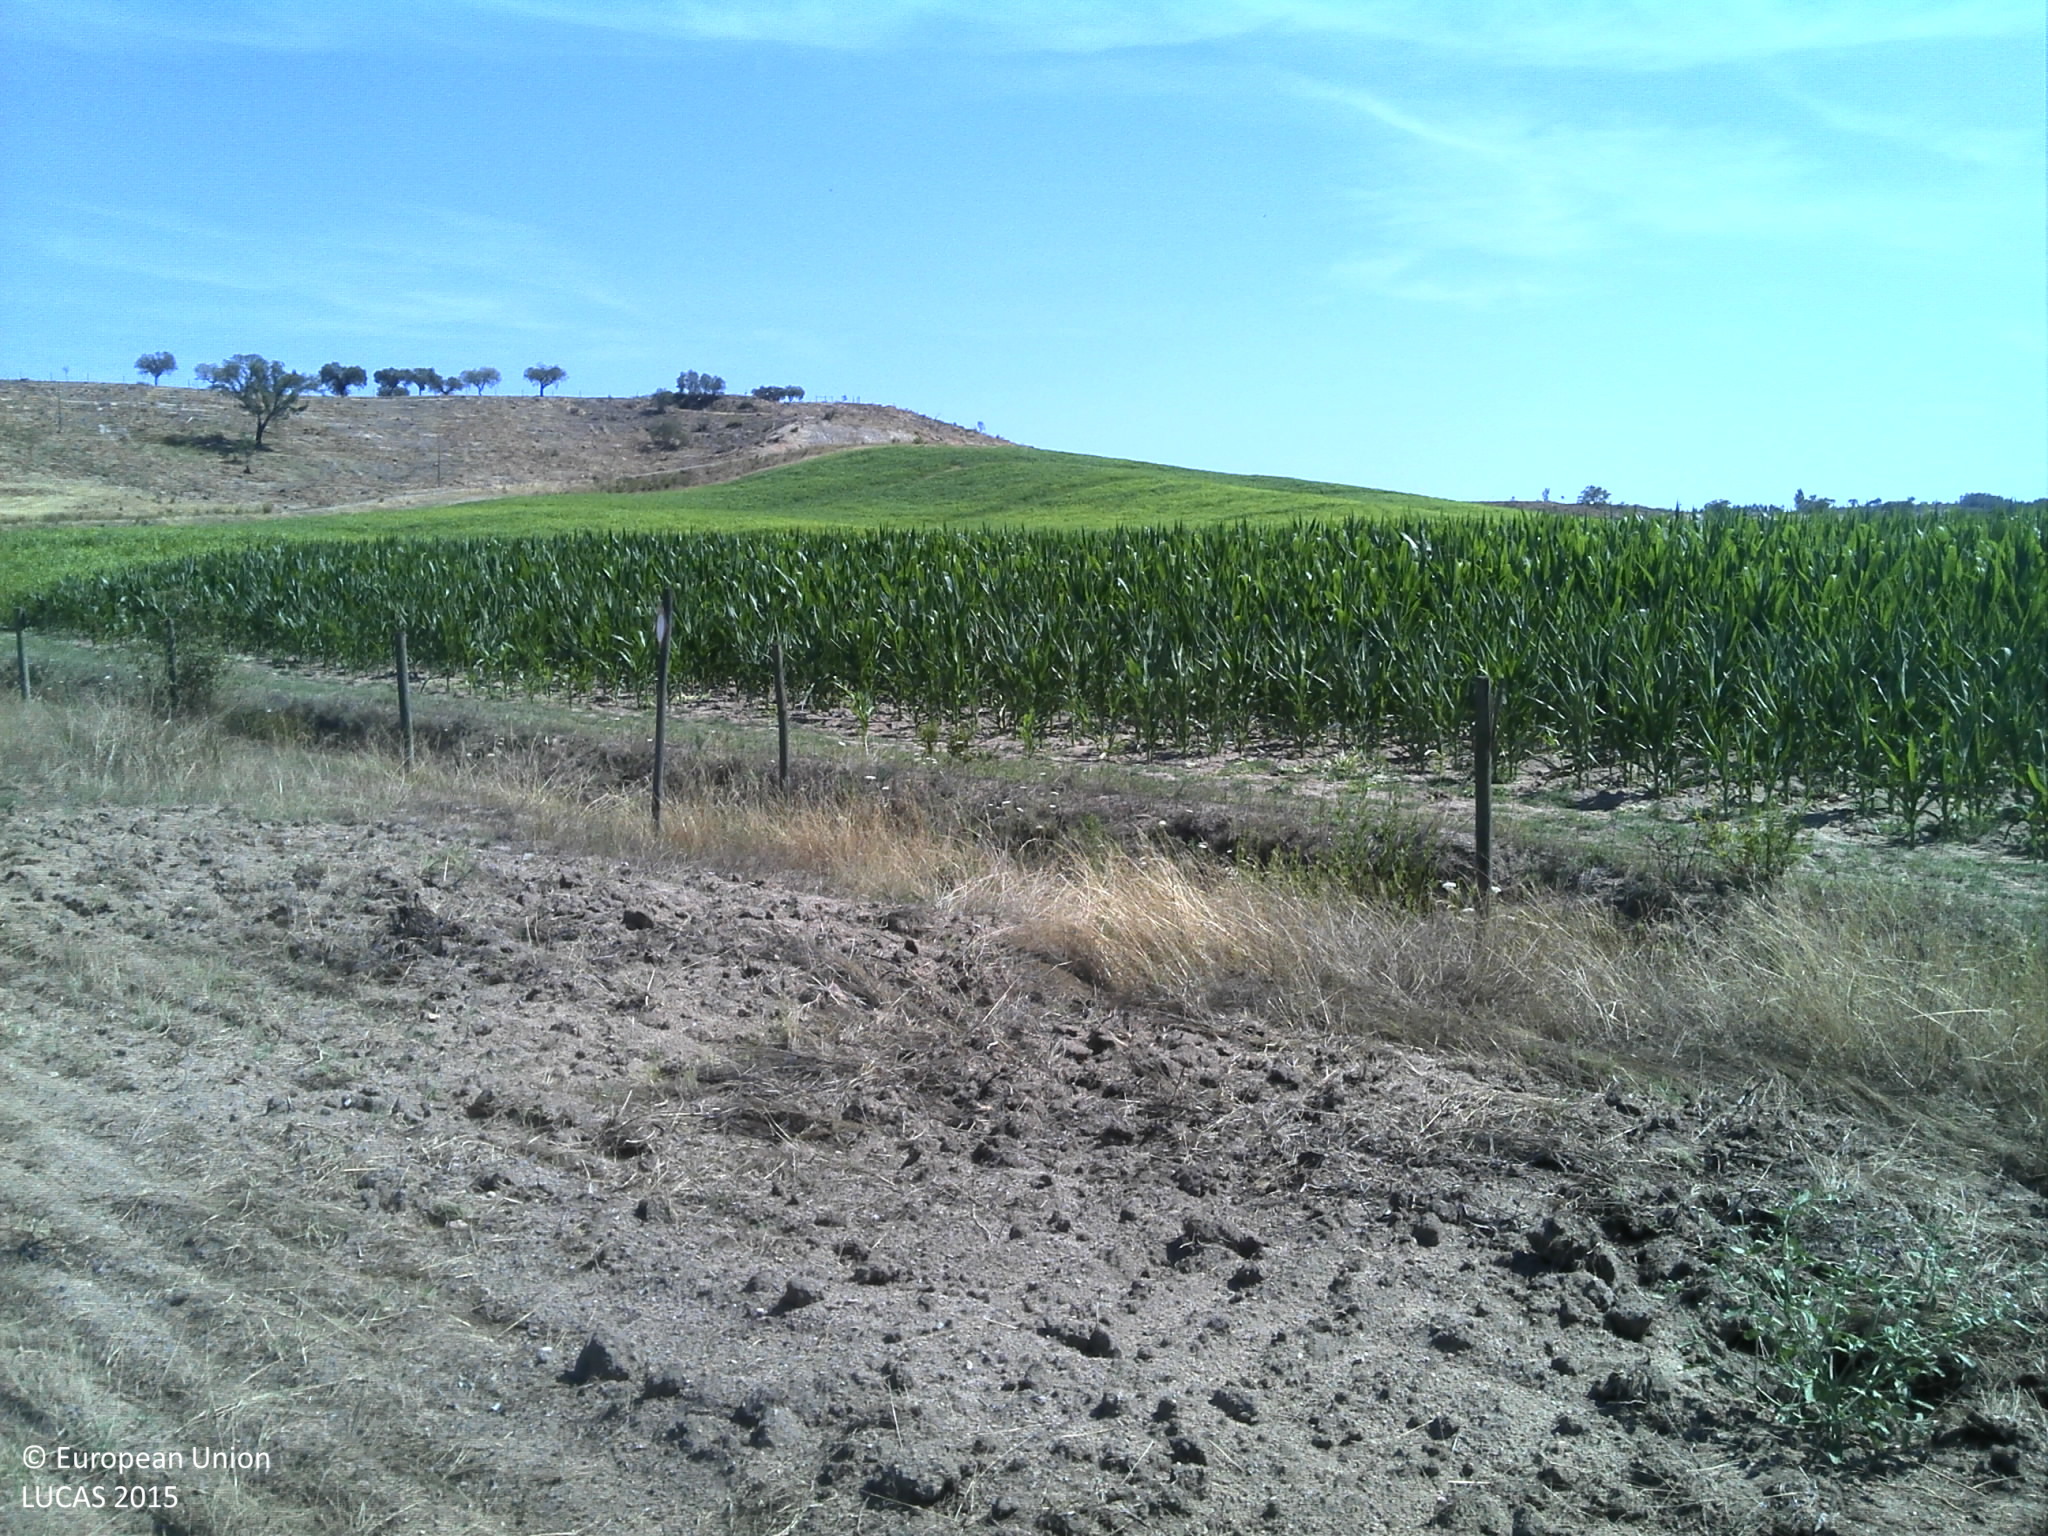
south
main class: Grassland
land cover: Spontaneously vegetated surfaces
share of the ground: 25 - 50 %
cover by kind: unconsolidated bare surface 50 %, herbaceous plants 45 %
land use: Agriculture (excluding fallow land and kitchen gardens)
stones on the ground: 10 - 25 %
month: July
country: PT
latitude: 39.6779
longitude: -7.5987
